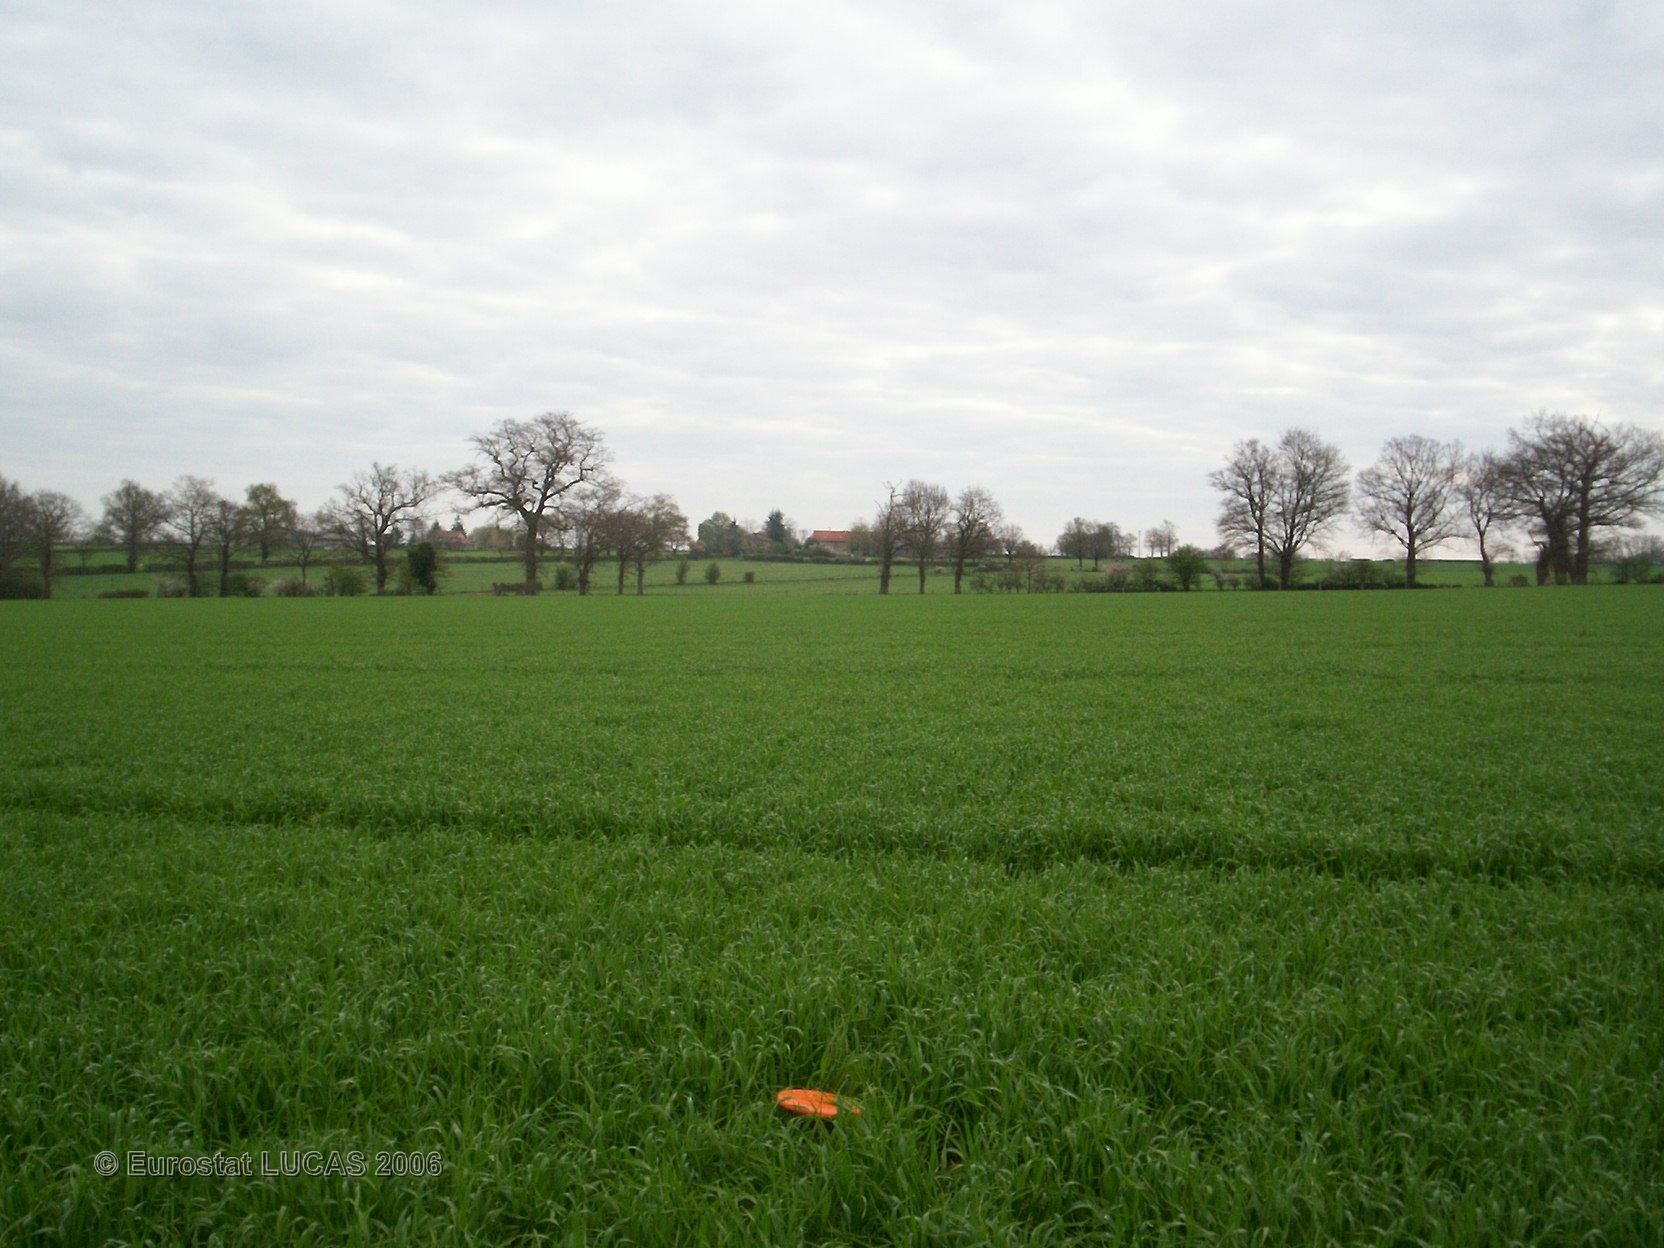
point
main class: Cropland
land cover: Barley
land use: Agriculture (excluding fallow land and kitchen gardens)
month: April
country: FR
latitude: 46.1492
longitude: 0.5459
